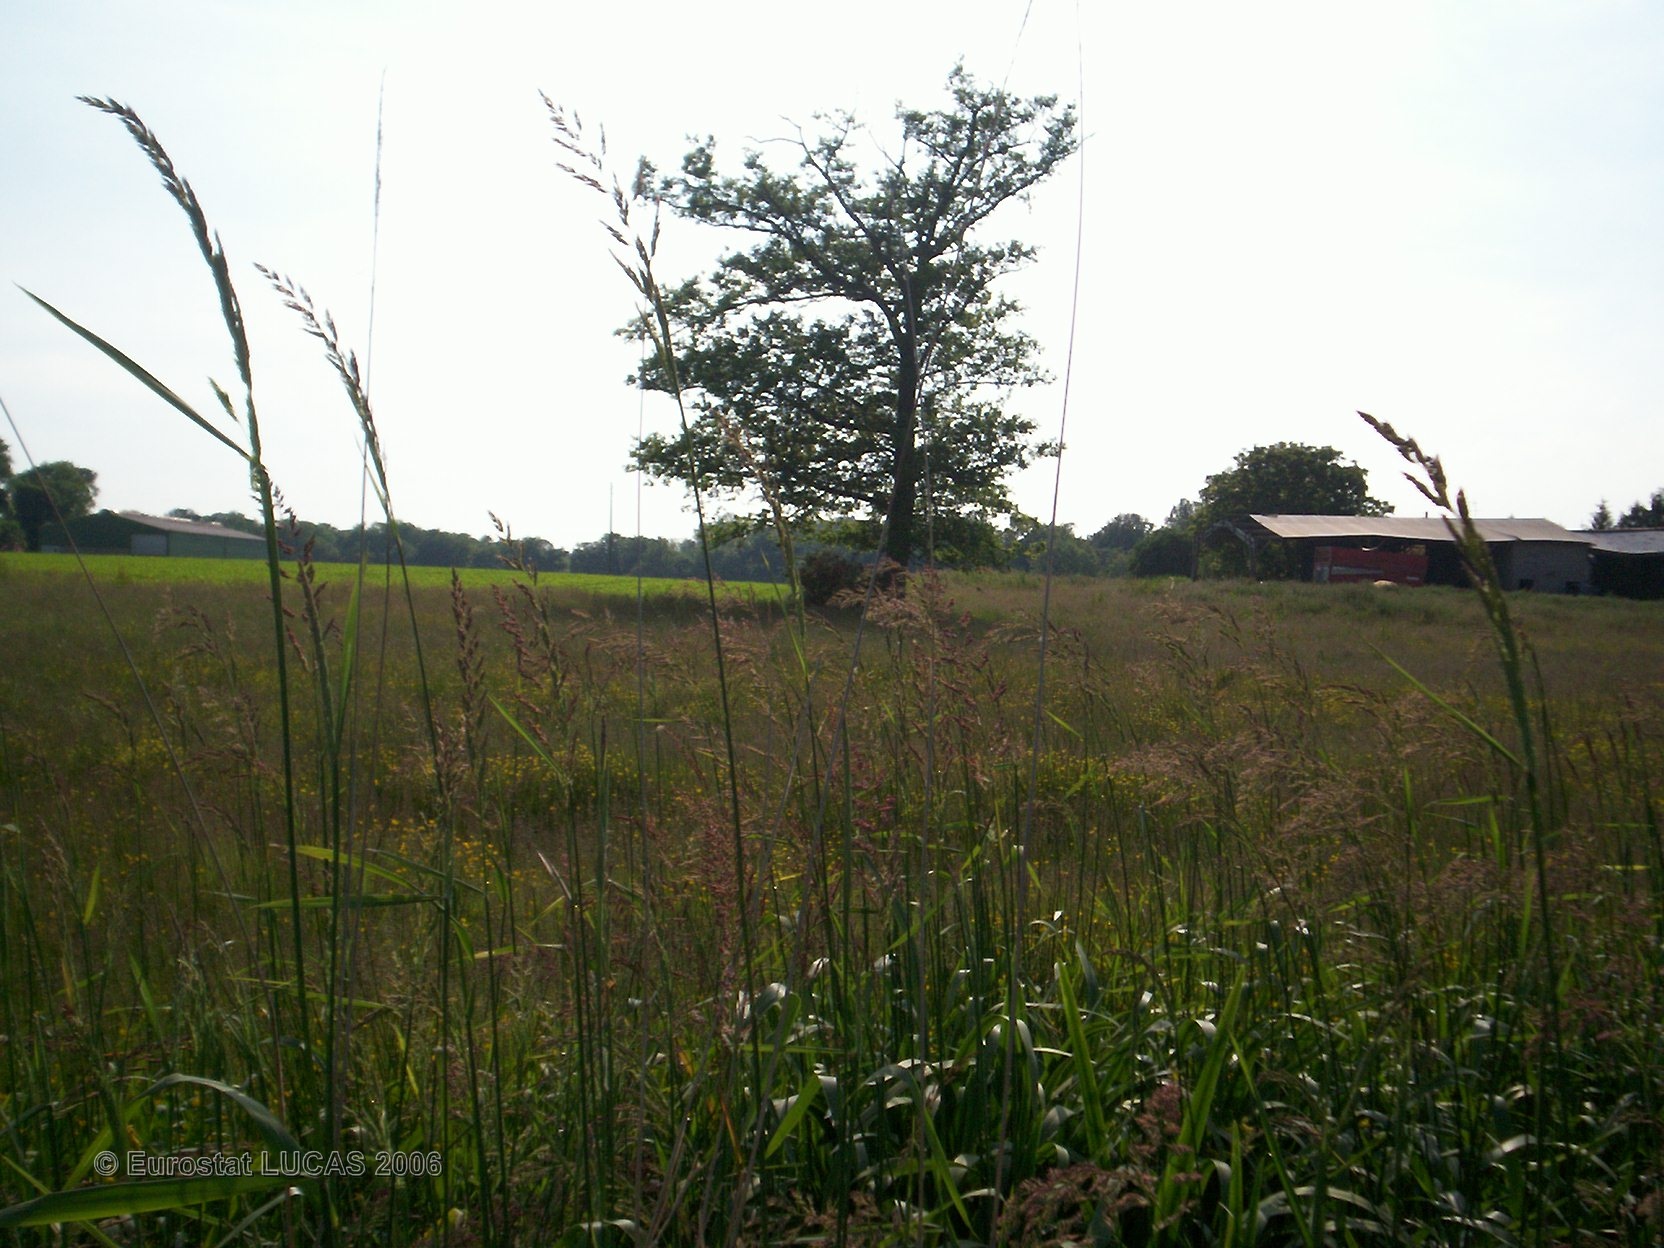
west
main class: Grassland
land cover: Grassland without tree/shrub cover
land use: Agriculture (excluding fallow land and kitchen gardens)
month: June
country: FR
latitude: 48.5421
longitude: -1.7123
